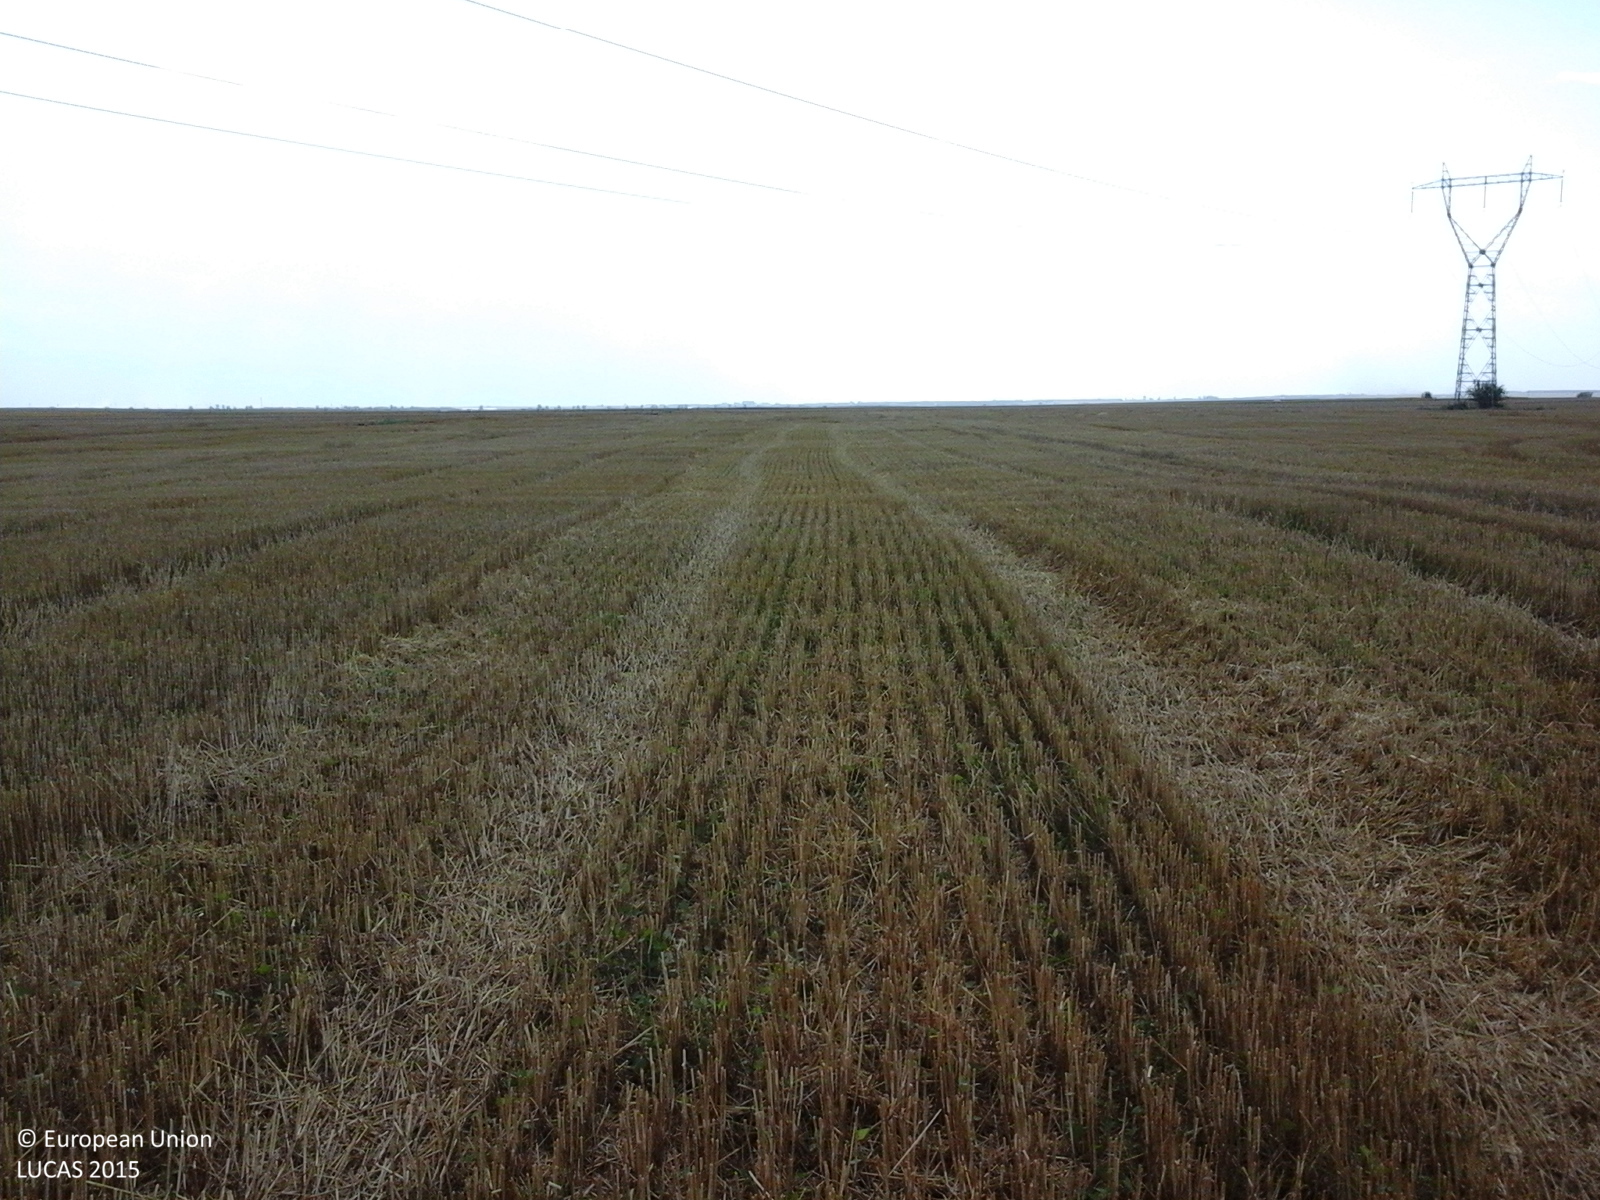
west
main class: Cropland
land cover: Common wheat
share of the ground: < 10 %
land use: Agriculture (excluding fallow land and kitchen gardens)
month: July
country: RO
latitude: 43.8941
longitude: 24.4934
